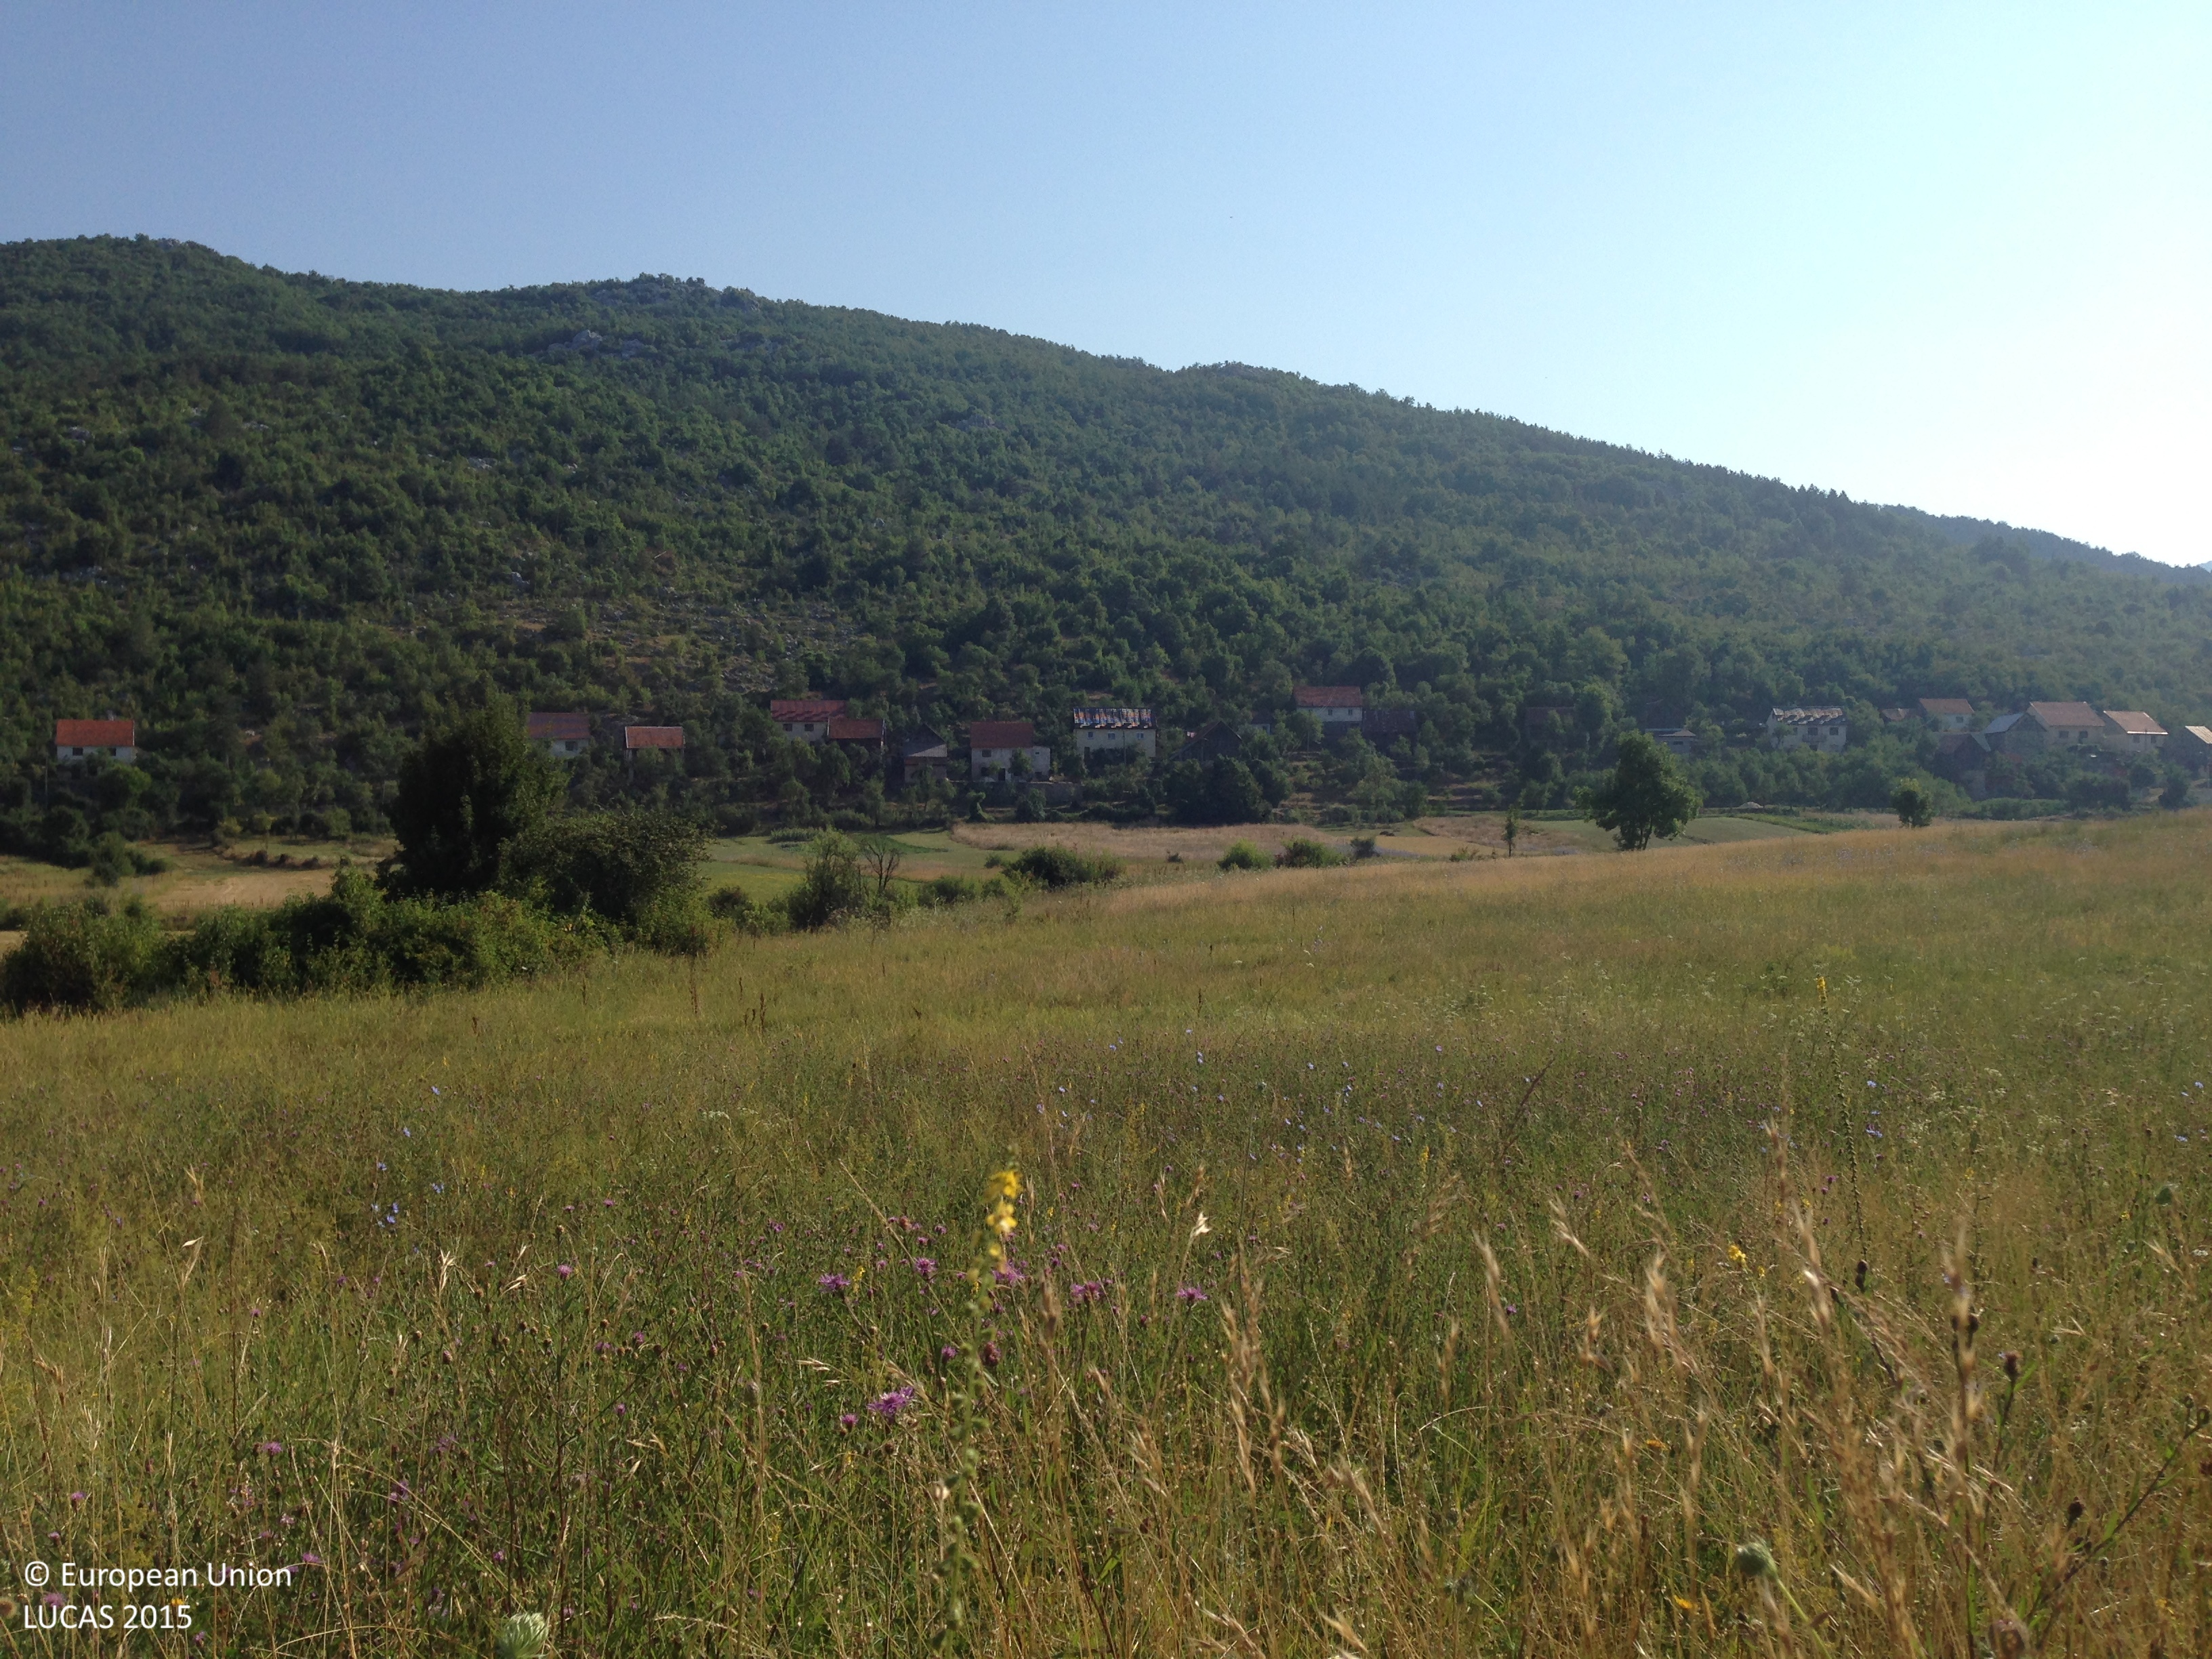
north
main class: Grassland
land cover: Grassland without tree/shrub cover
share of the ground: > 75 %
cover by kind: herbaceous plants 95 %, shrubs 5 %
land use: Agriculture (excluding fallow land and kitchen gardens)
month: July
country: HR
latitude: 44.7604
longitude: 15.2367
